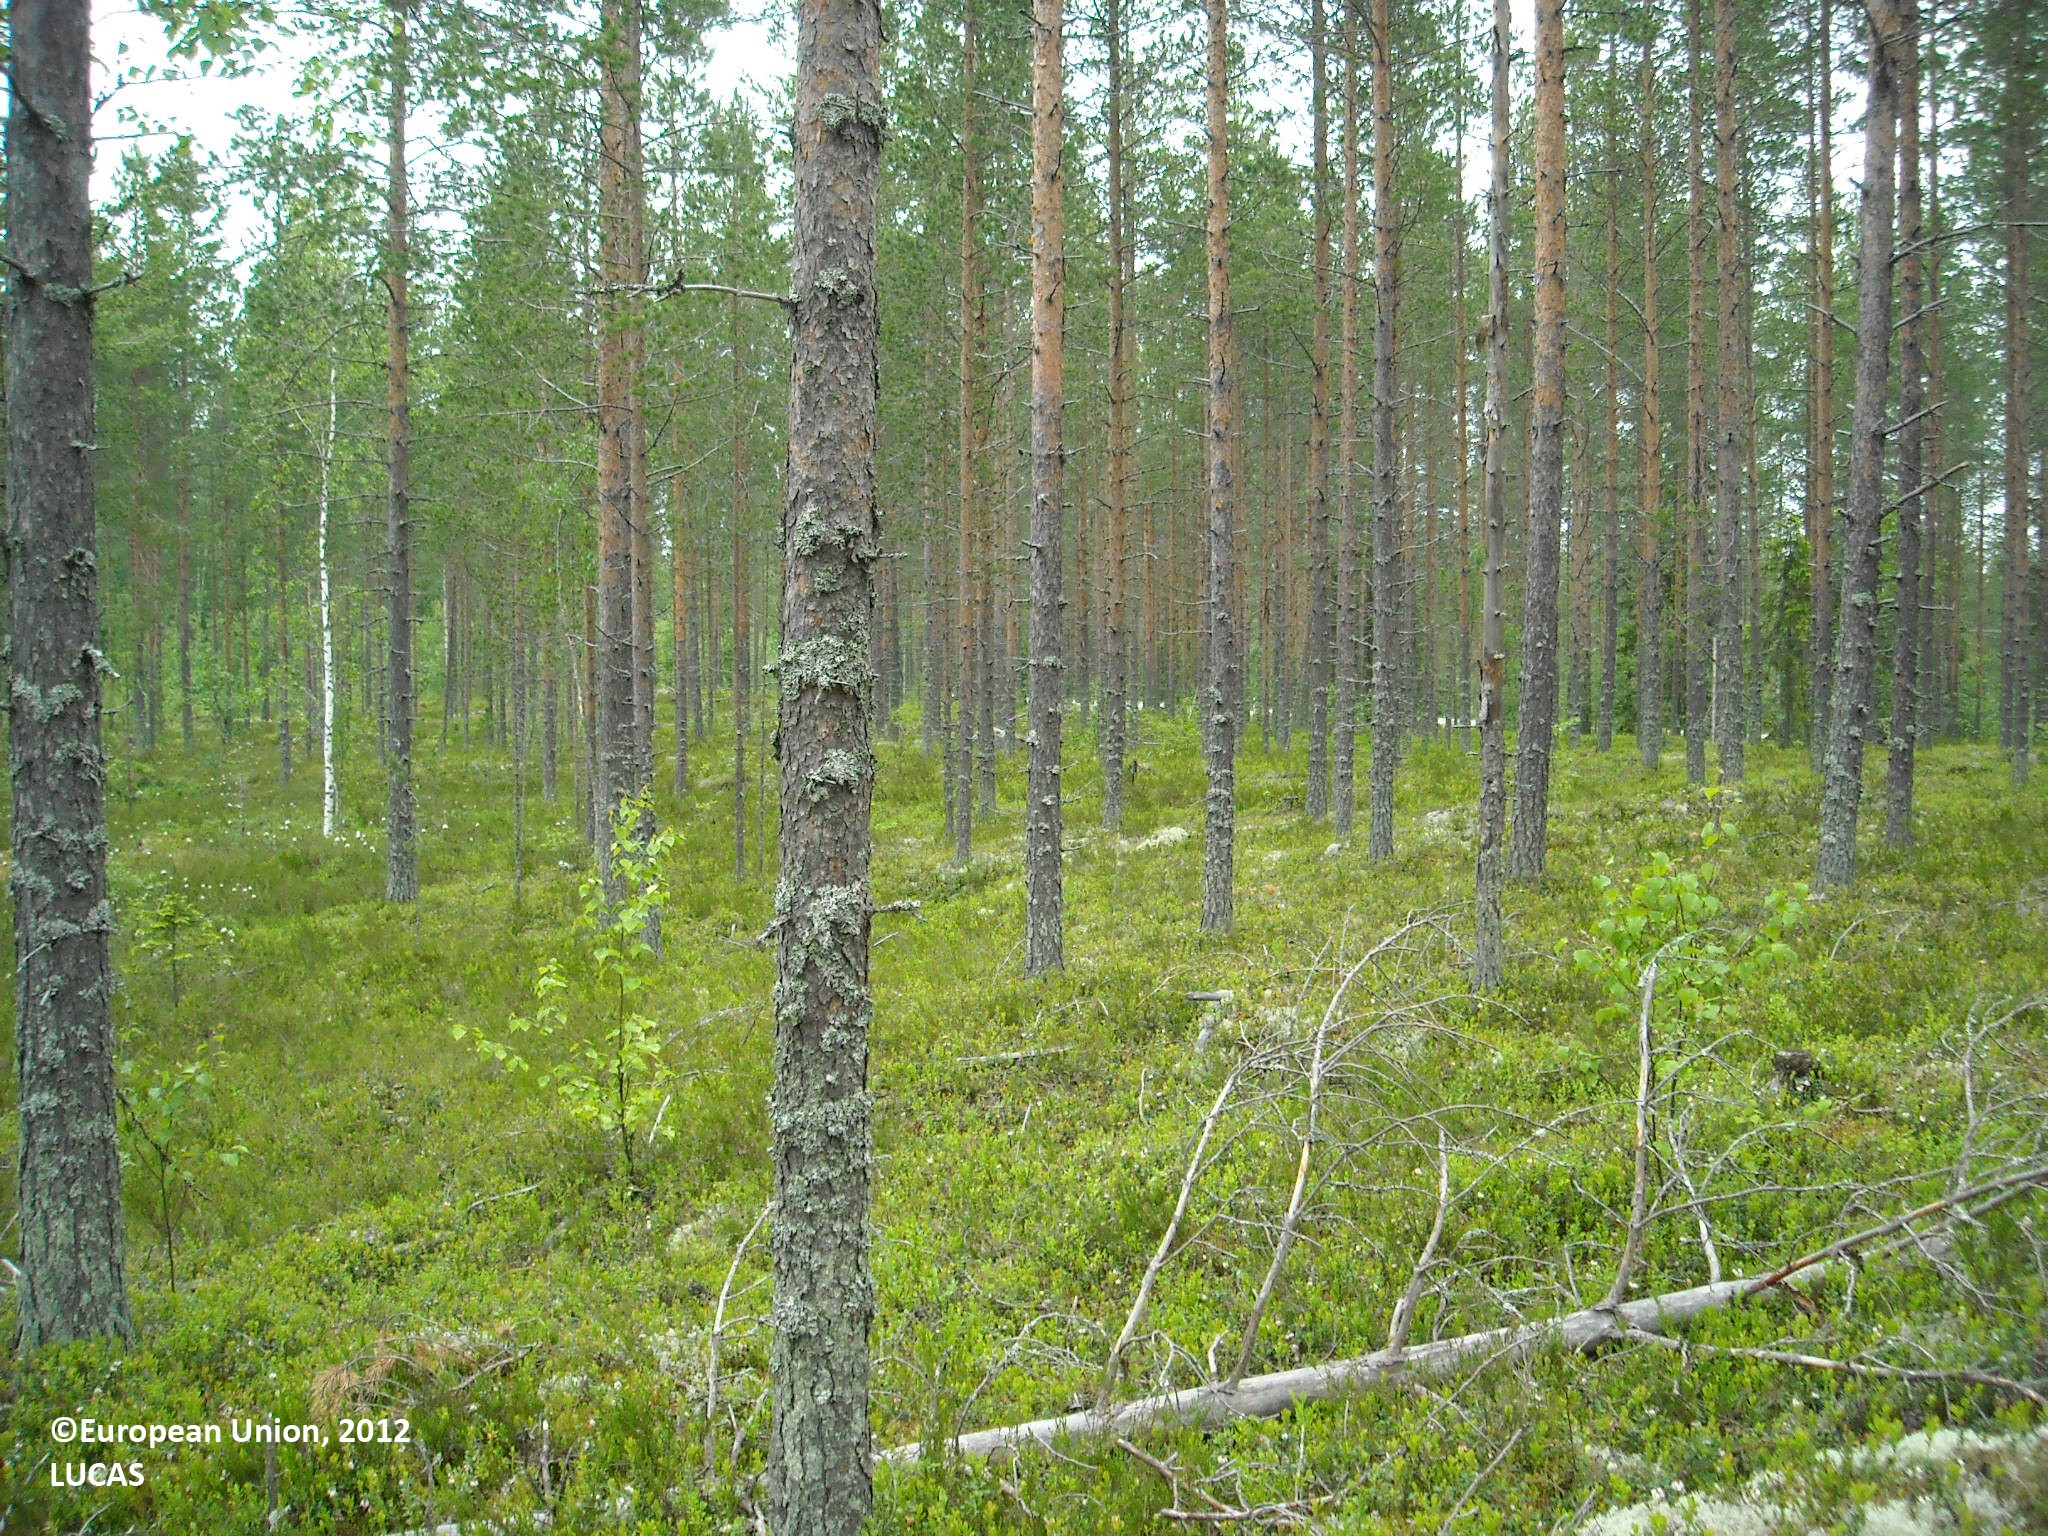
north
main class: Woodland
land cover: Pine dominated coniferous woodland
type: boreal forest
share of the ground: 50 - 75 %
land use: Forestry
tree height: > 5 m
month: June
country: FI
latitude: 64.4952
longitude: 27.3097
